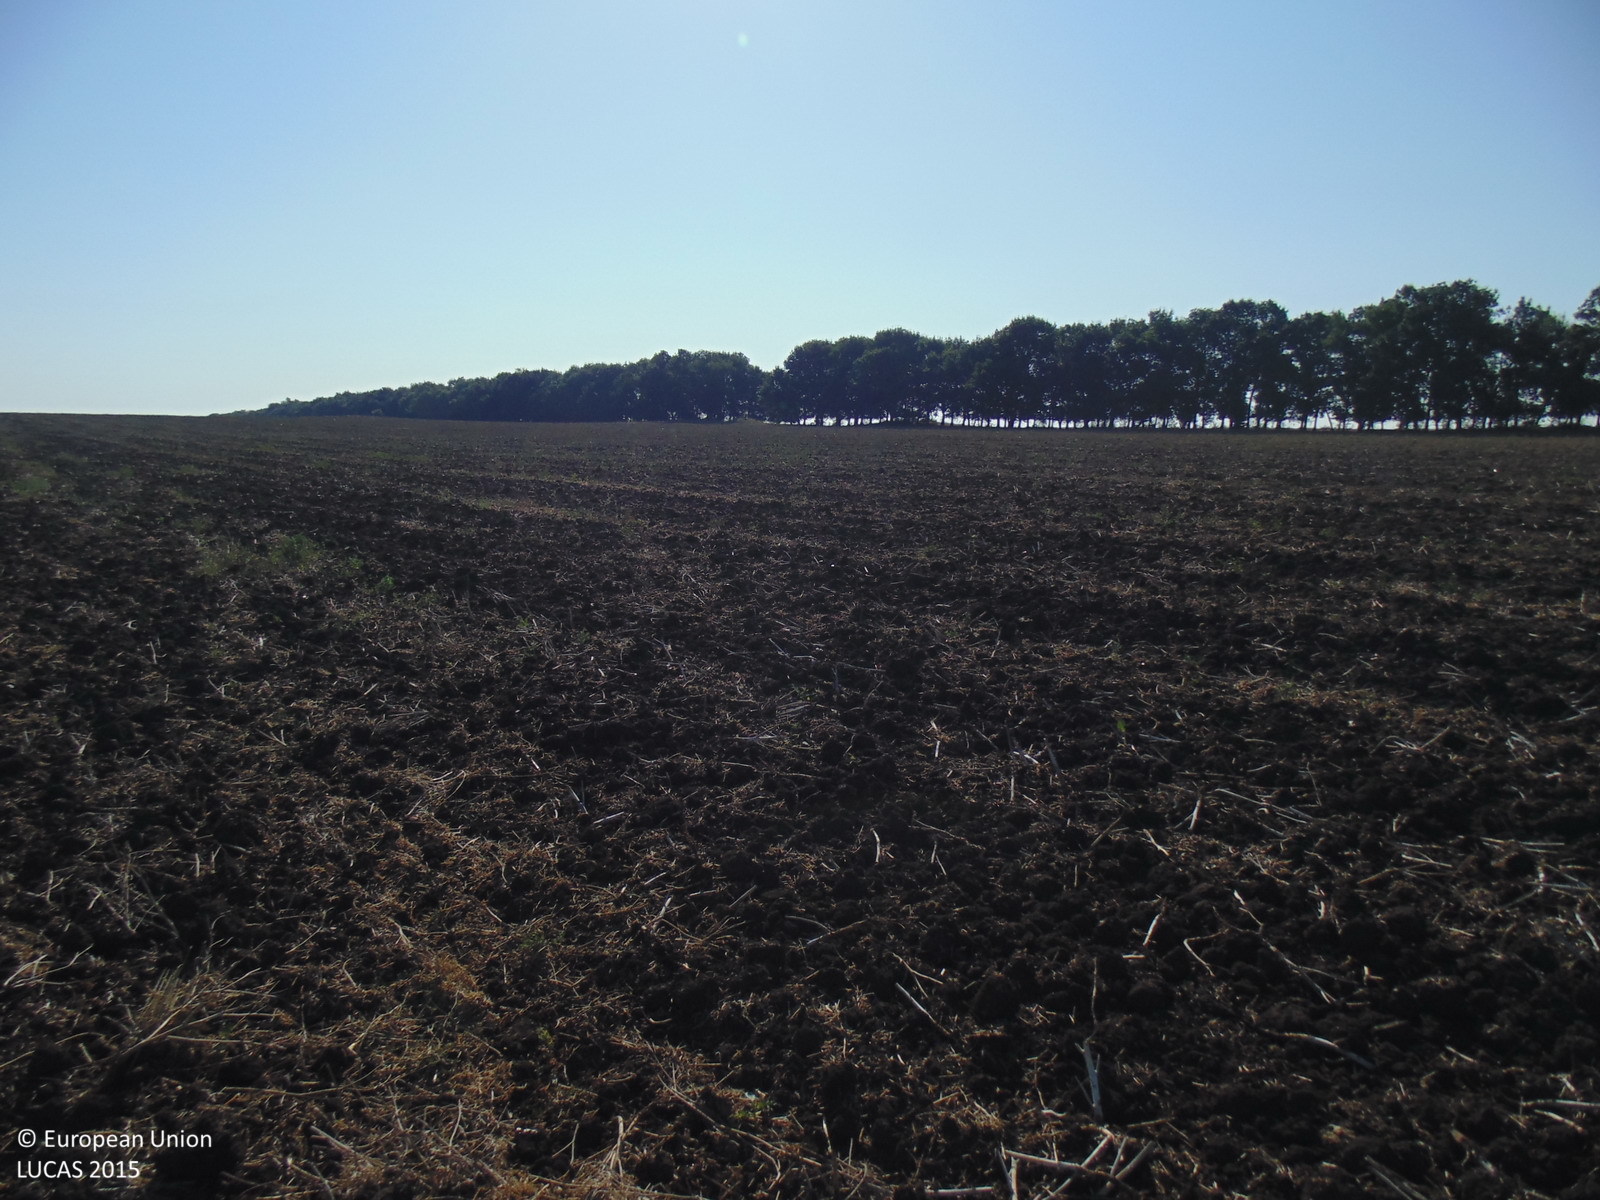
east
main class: Cropland
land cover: Rape and turnip rape
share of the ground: < 10 %
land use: Agriculture (excluding fallow land and kitchen gardens)
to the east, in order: Rape and turnip rape
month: August
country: BG
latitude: 43.5742
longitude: 28.0918
